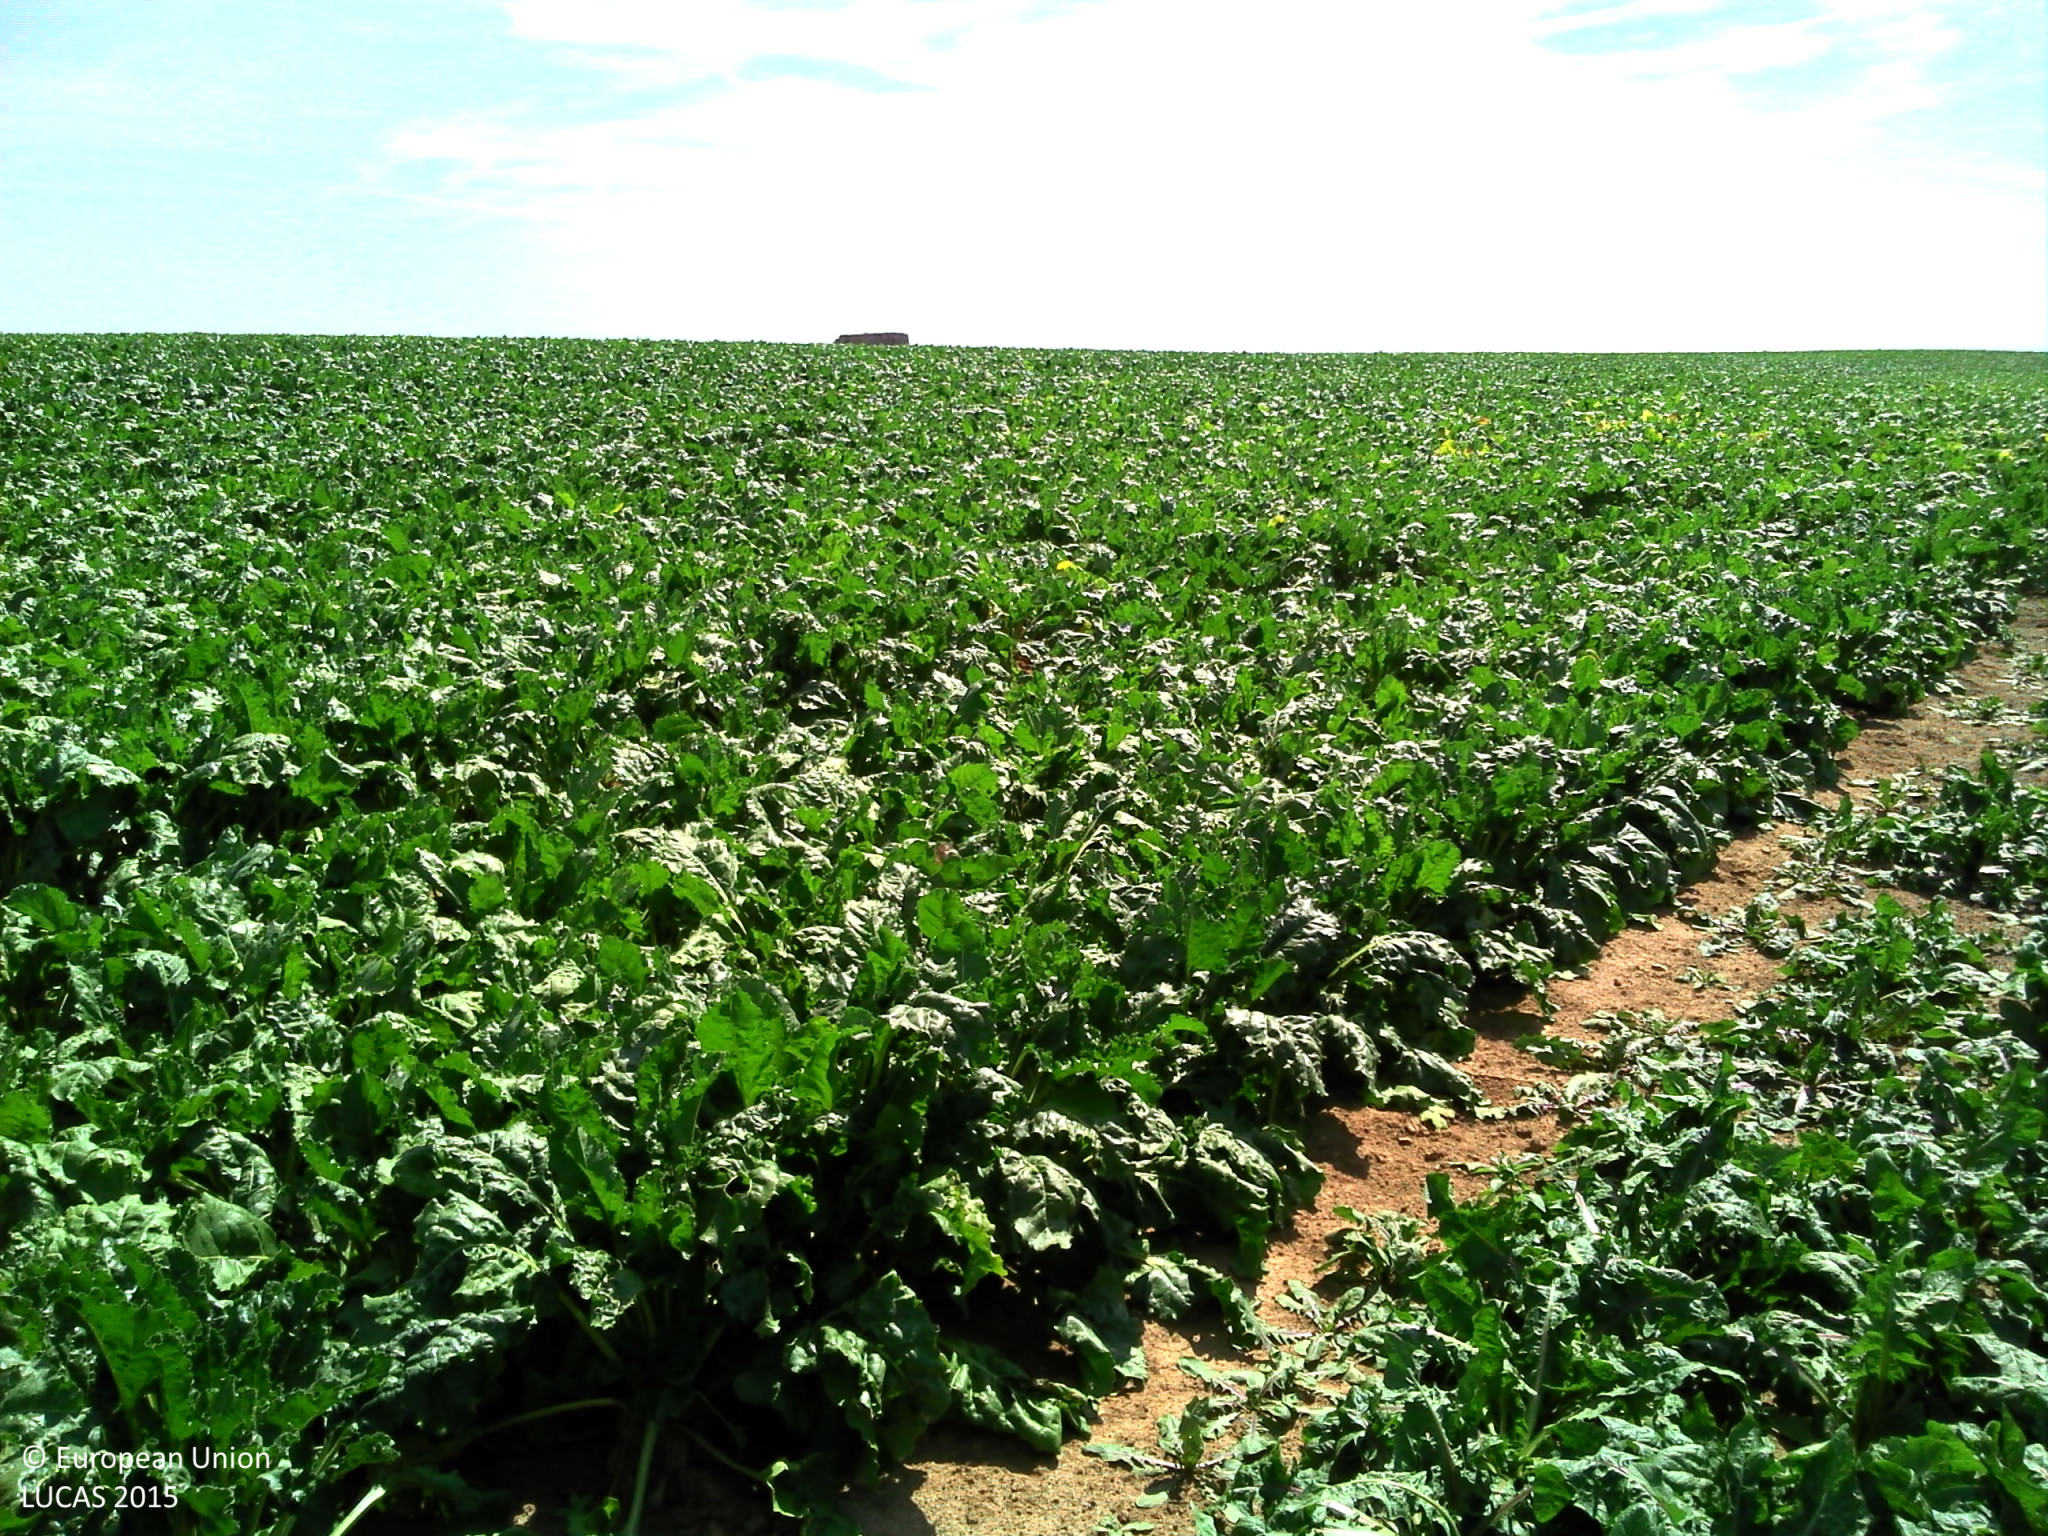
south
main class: Cropland
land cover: Other root crops
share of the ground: > 75 %
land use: Agriculture (excluding fallow land and kitchen gardens)
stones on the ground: < 10 %
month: August
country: FR
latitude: 50.2333
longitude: 3.1917
